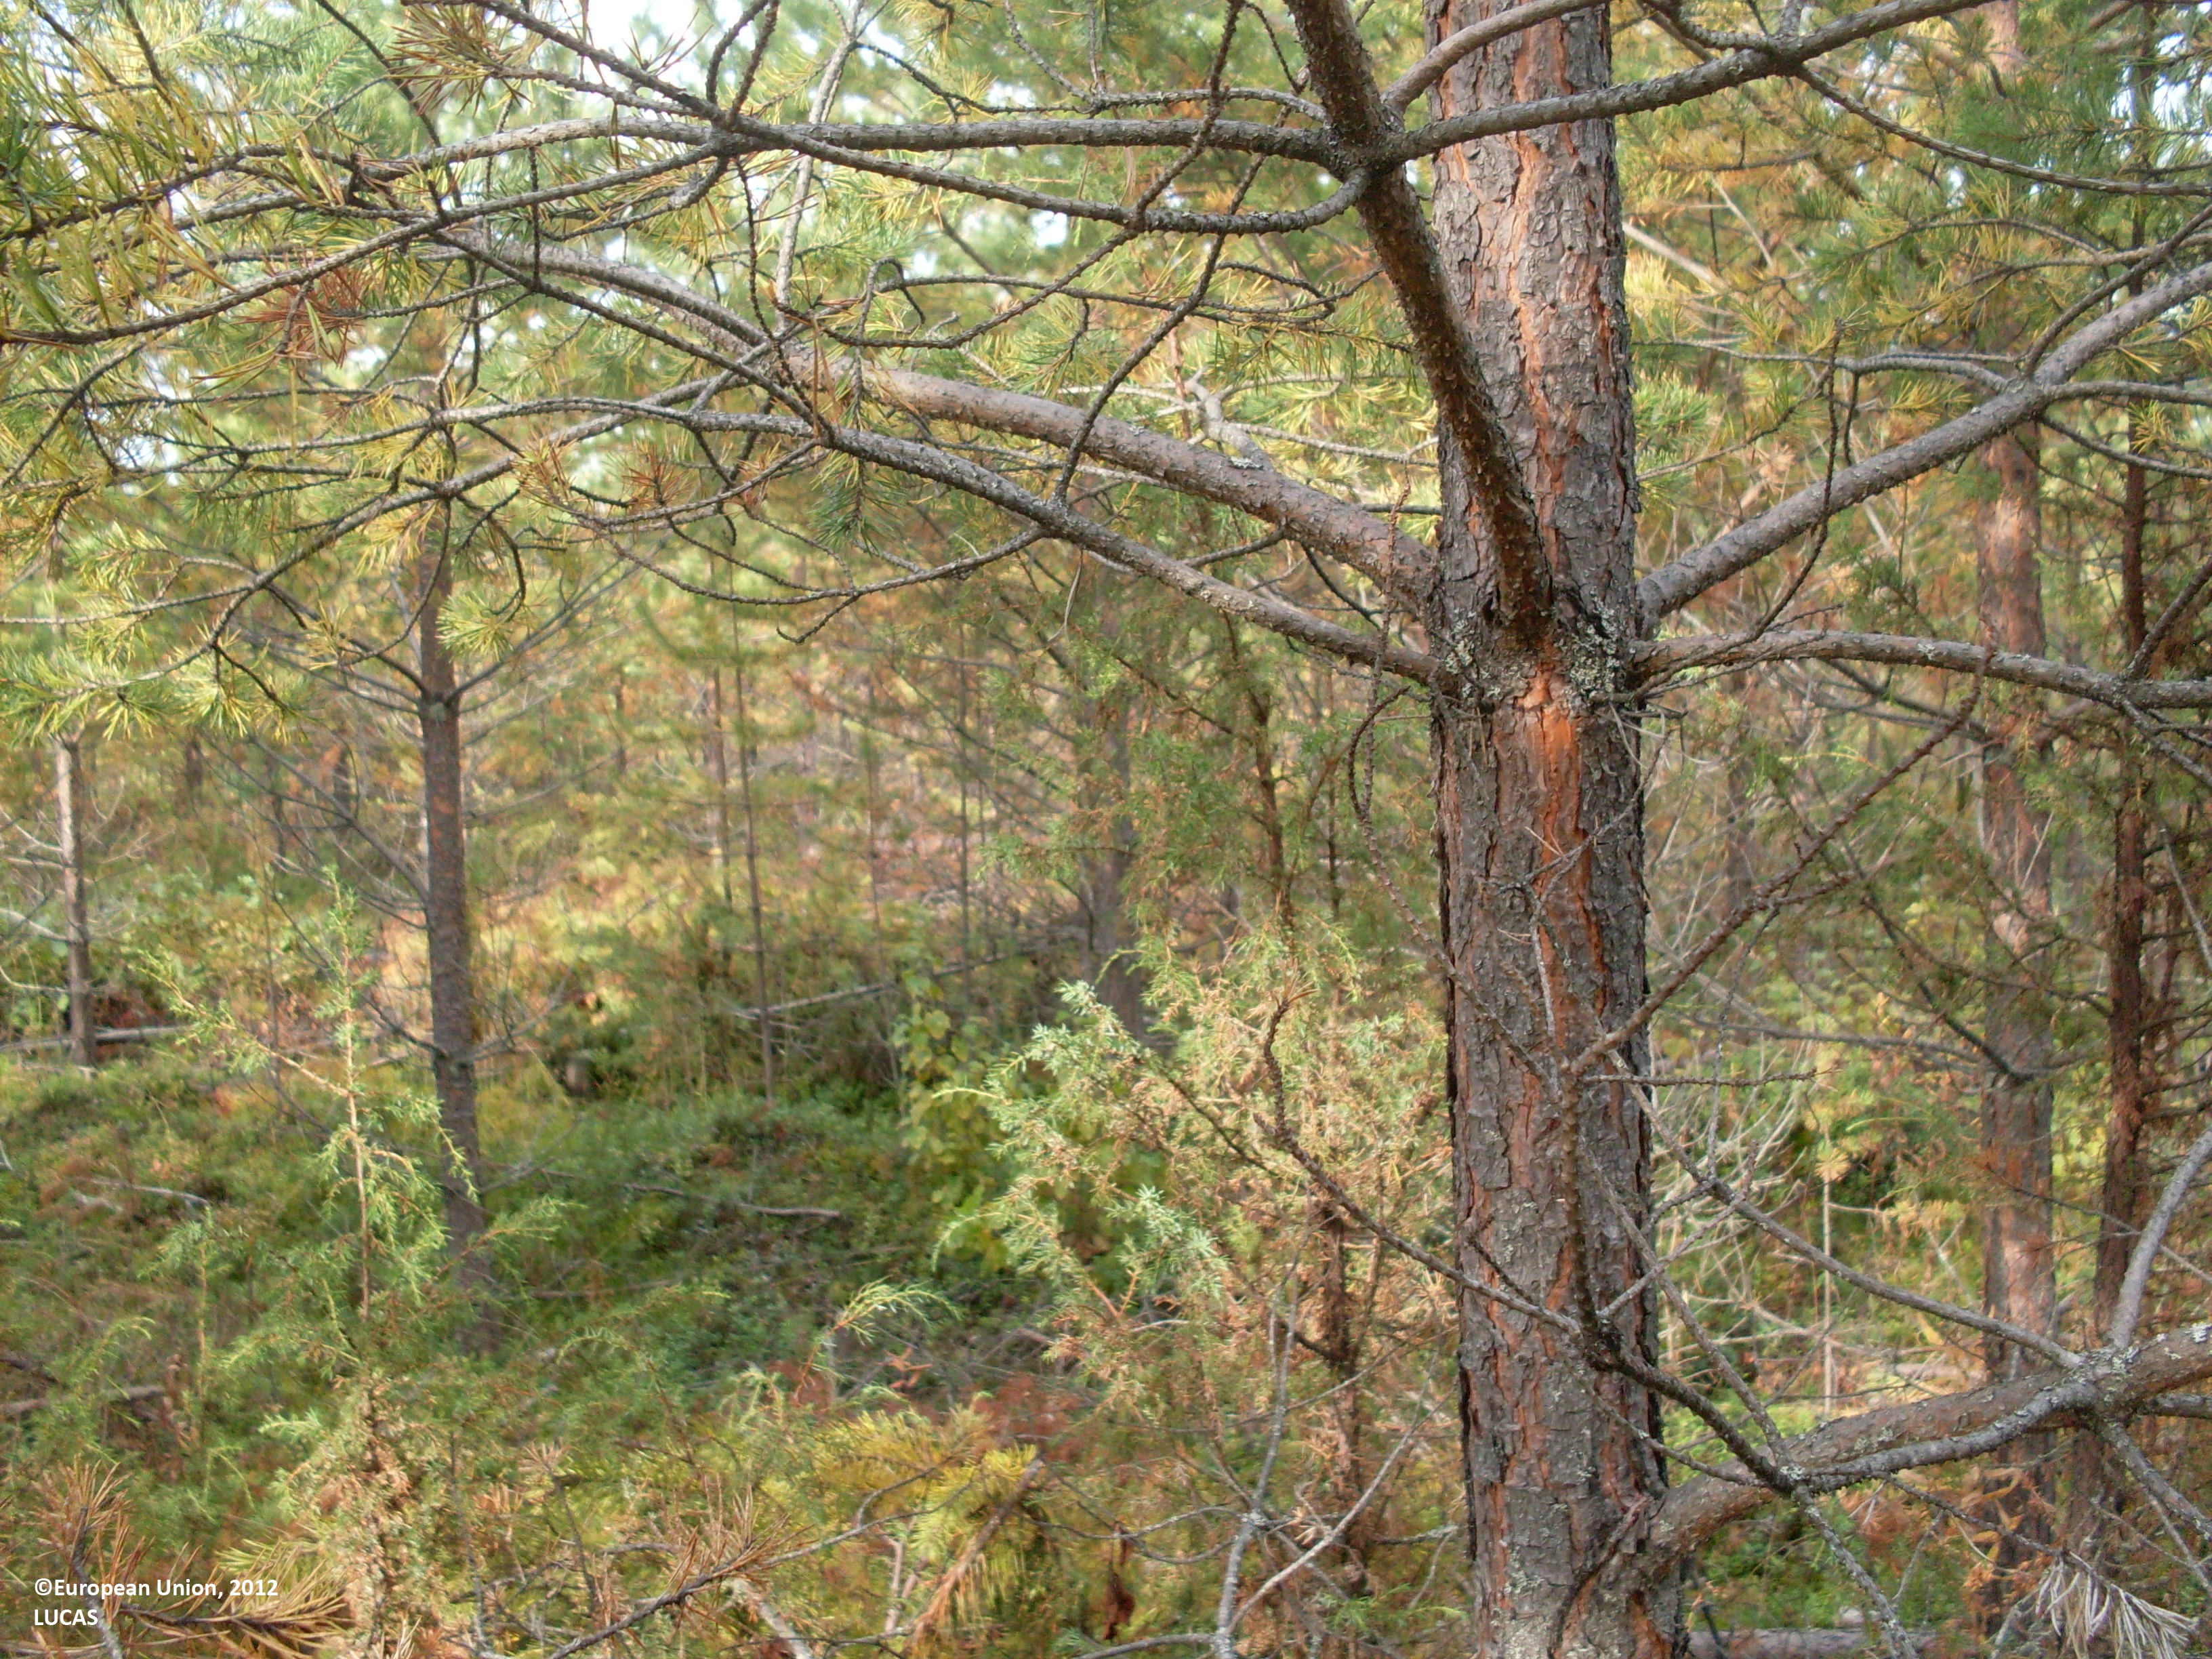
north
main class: Woodland
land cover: Pine dominated coniferous woodland
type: boreal forest
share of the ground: > 75 %
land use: Forestry
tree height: > 5 m
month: September
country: FI
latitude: 64.1234
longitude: 28.4358
